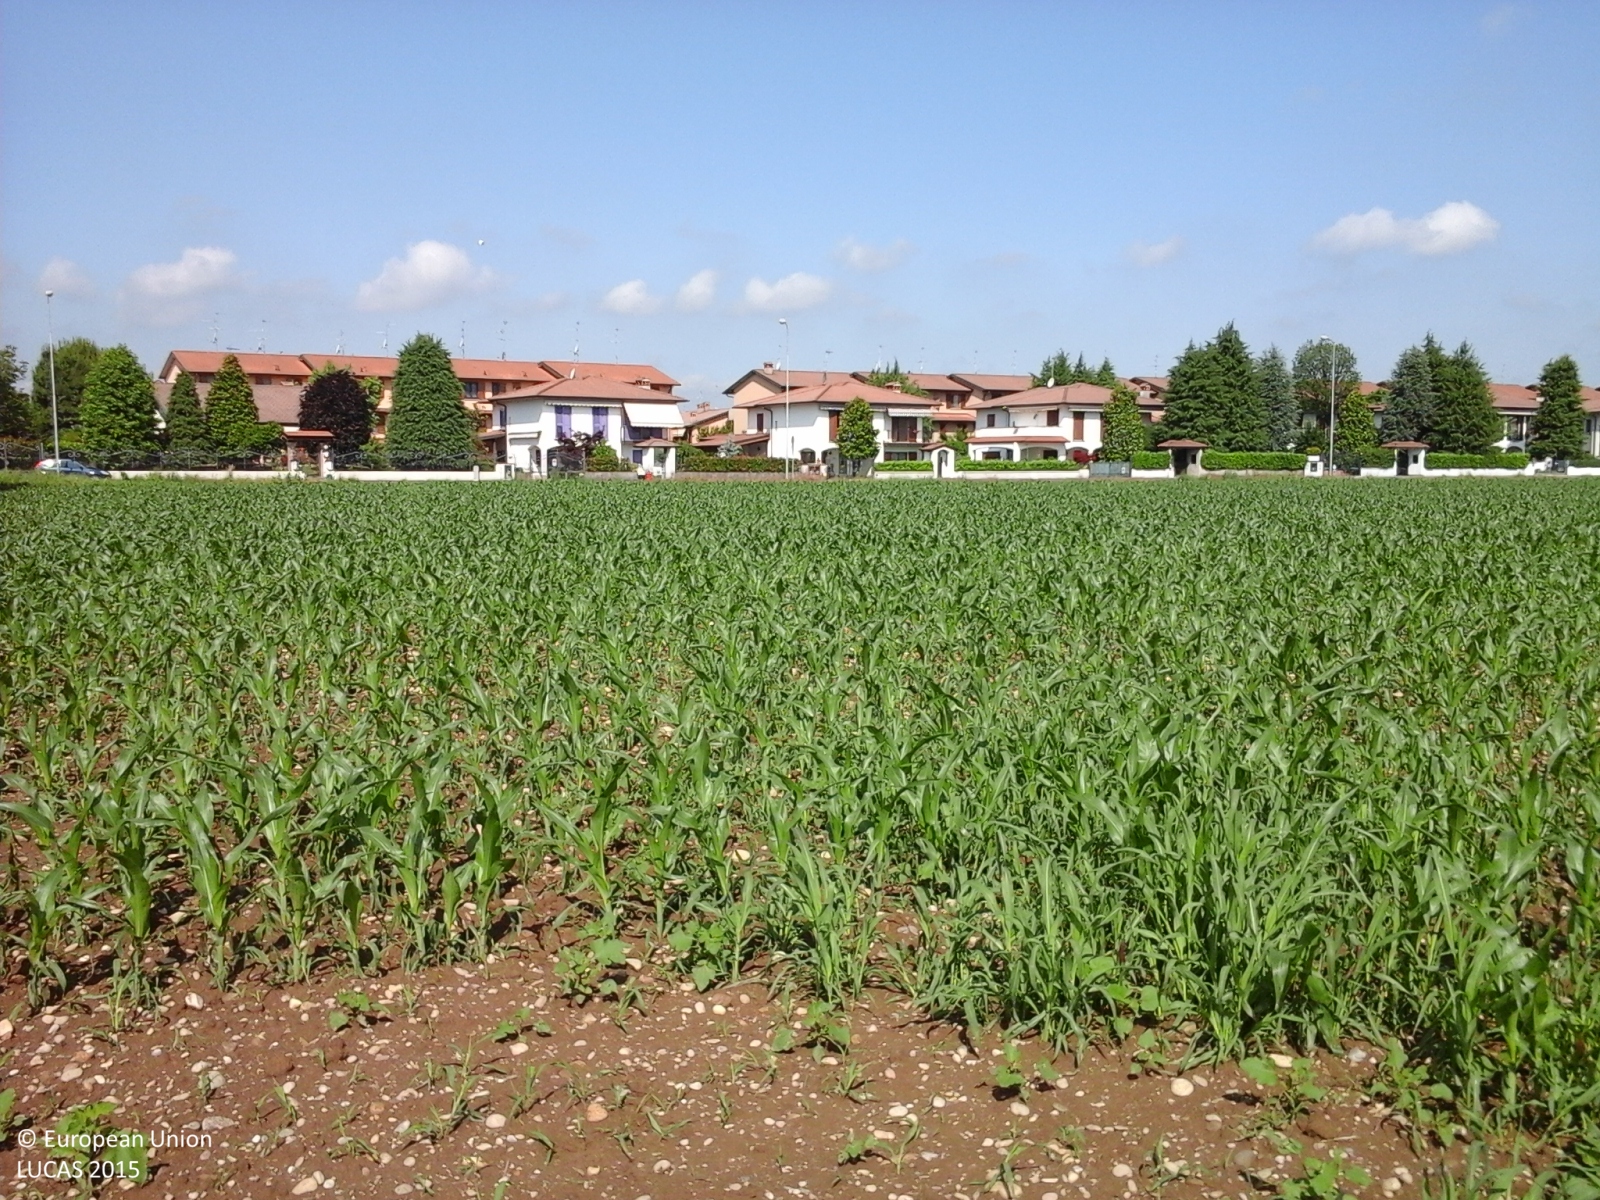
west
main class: Cropland
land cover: Maize
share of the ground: 50 - 75 %
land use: Agriculture (excluding fallow land and kitchen gardens)
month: May
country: IT
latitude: 45.4133
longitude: 9.5536
